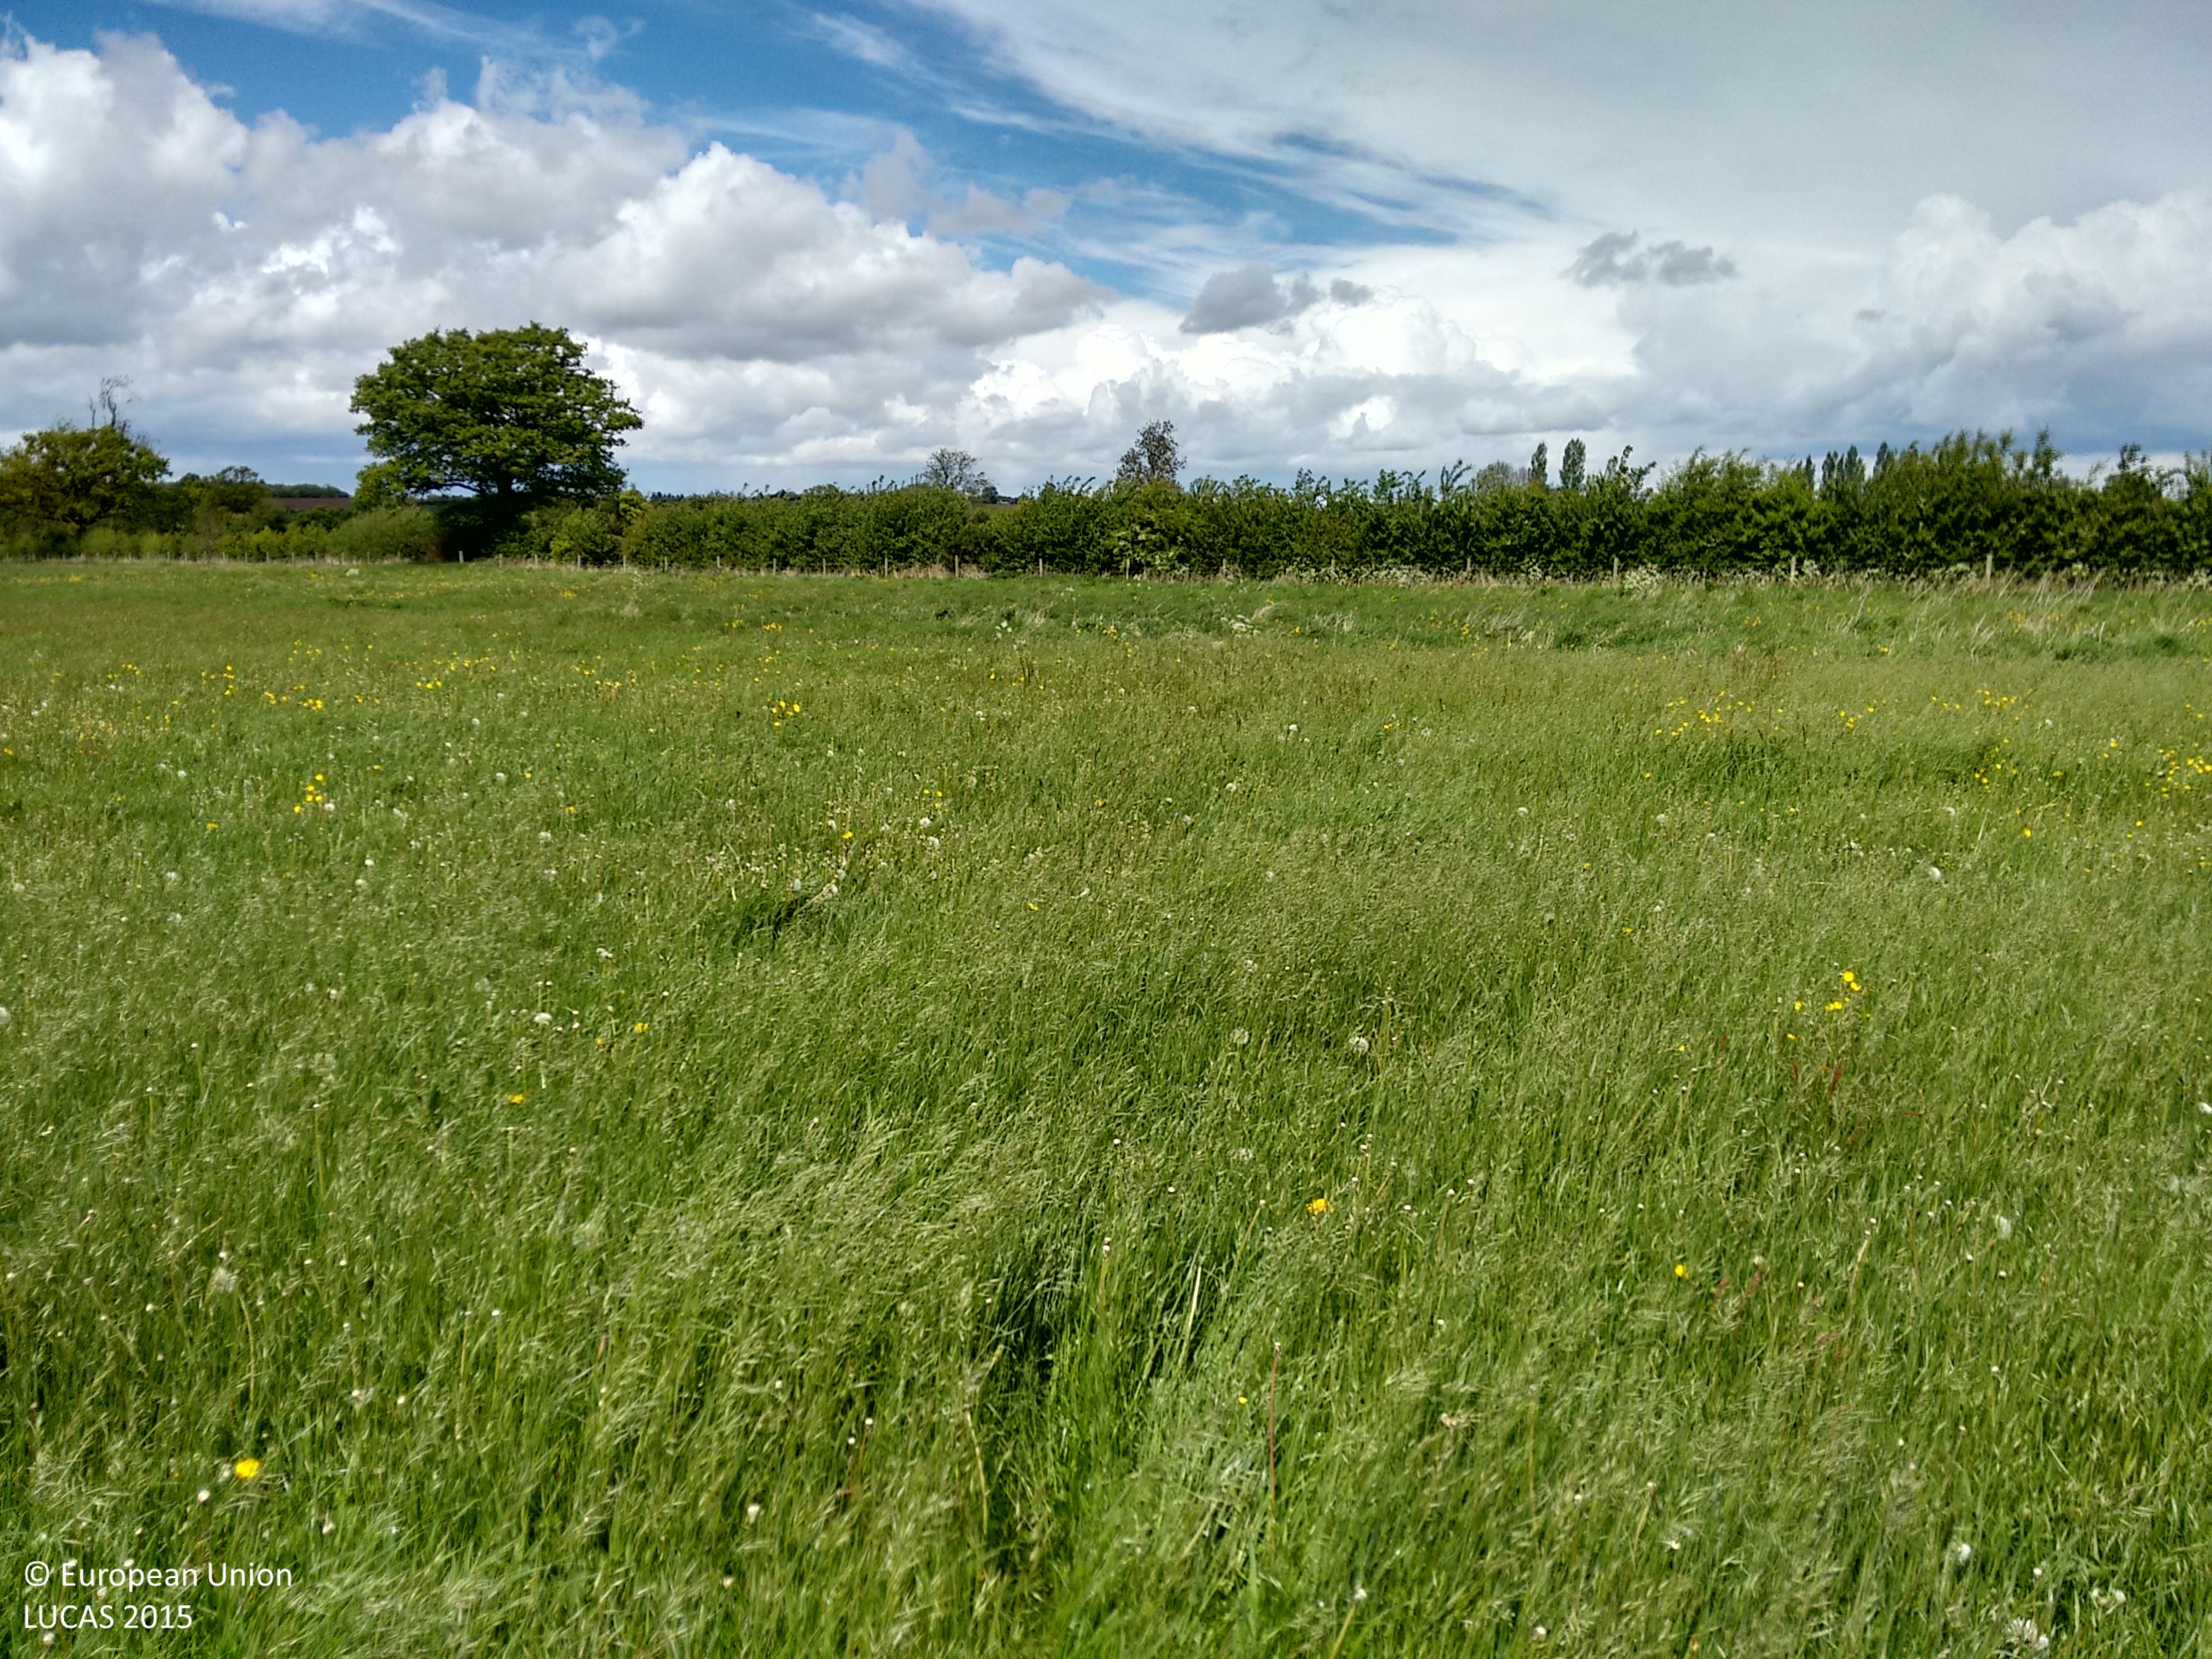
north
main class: Grassland
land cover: Grassland without tree/shrub cover
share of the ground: > 75 %
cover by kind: herbaceous plants 100 %
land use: Agriculture (excluding fallow land and kitchen gardens)
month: May
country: GB
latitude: 52.3447
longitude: -1.4858
